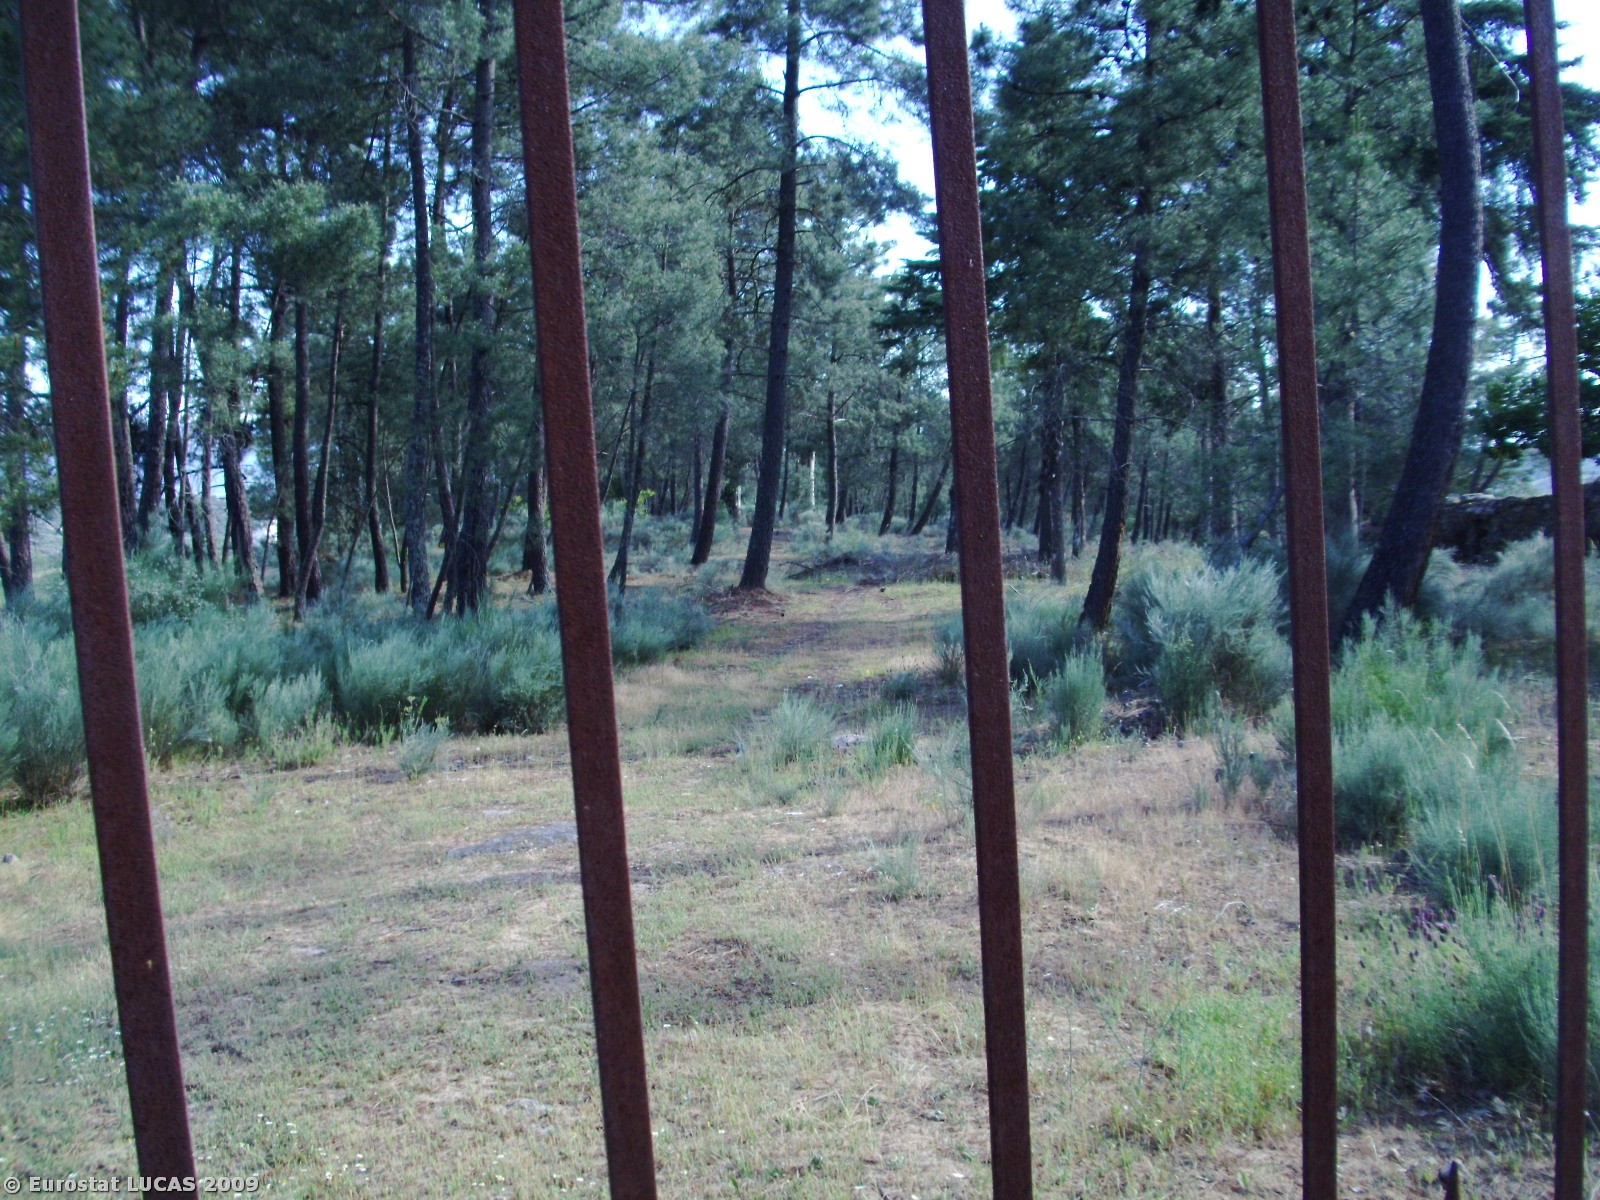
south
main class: Grassland
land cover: Spontaneously vegetated surfaces
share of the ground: > 75 %
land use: Fallow land
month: May
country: PT
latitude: 40.6575
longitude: -7.4879
